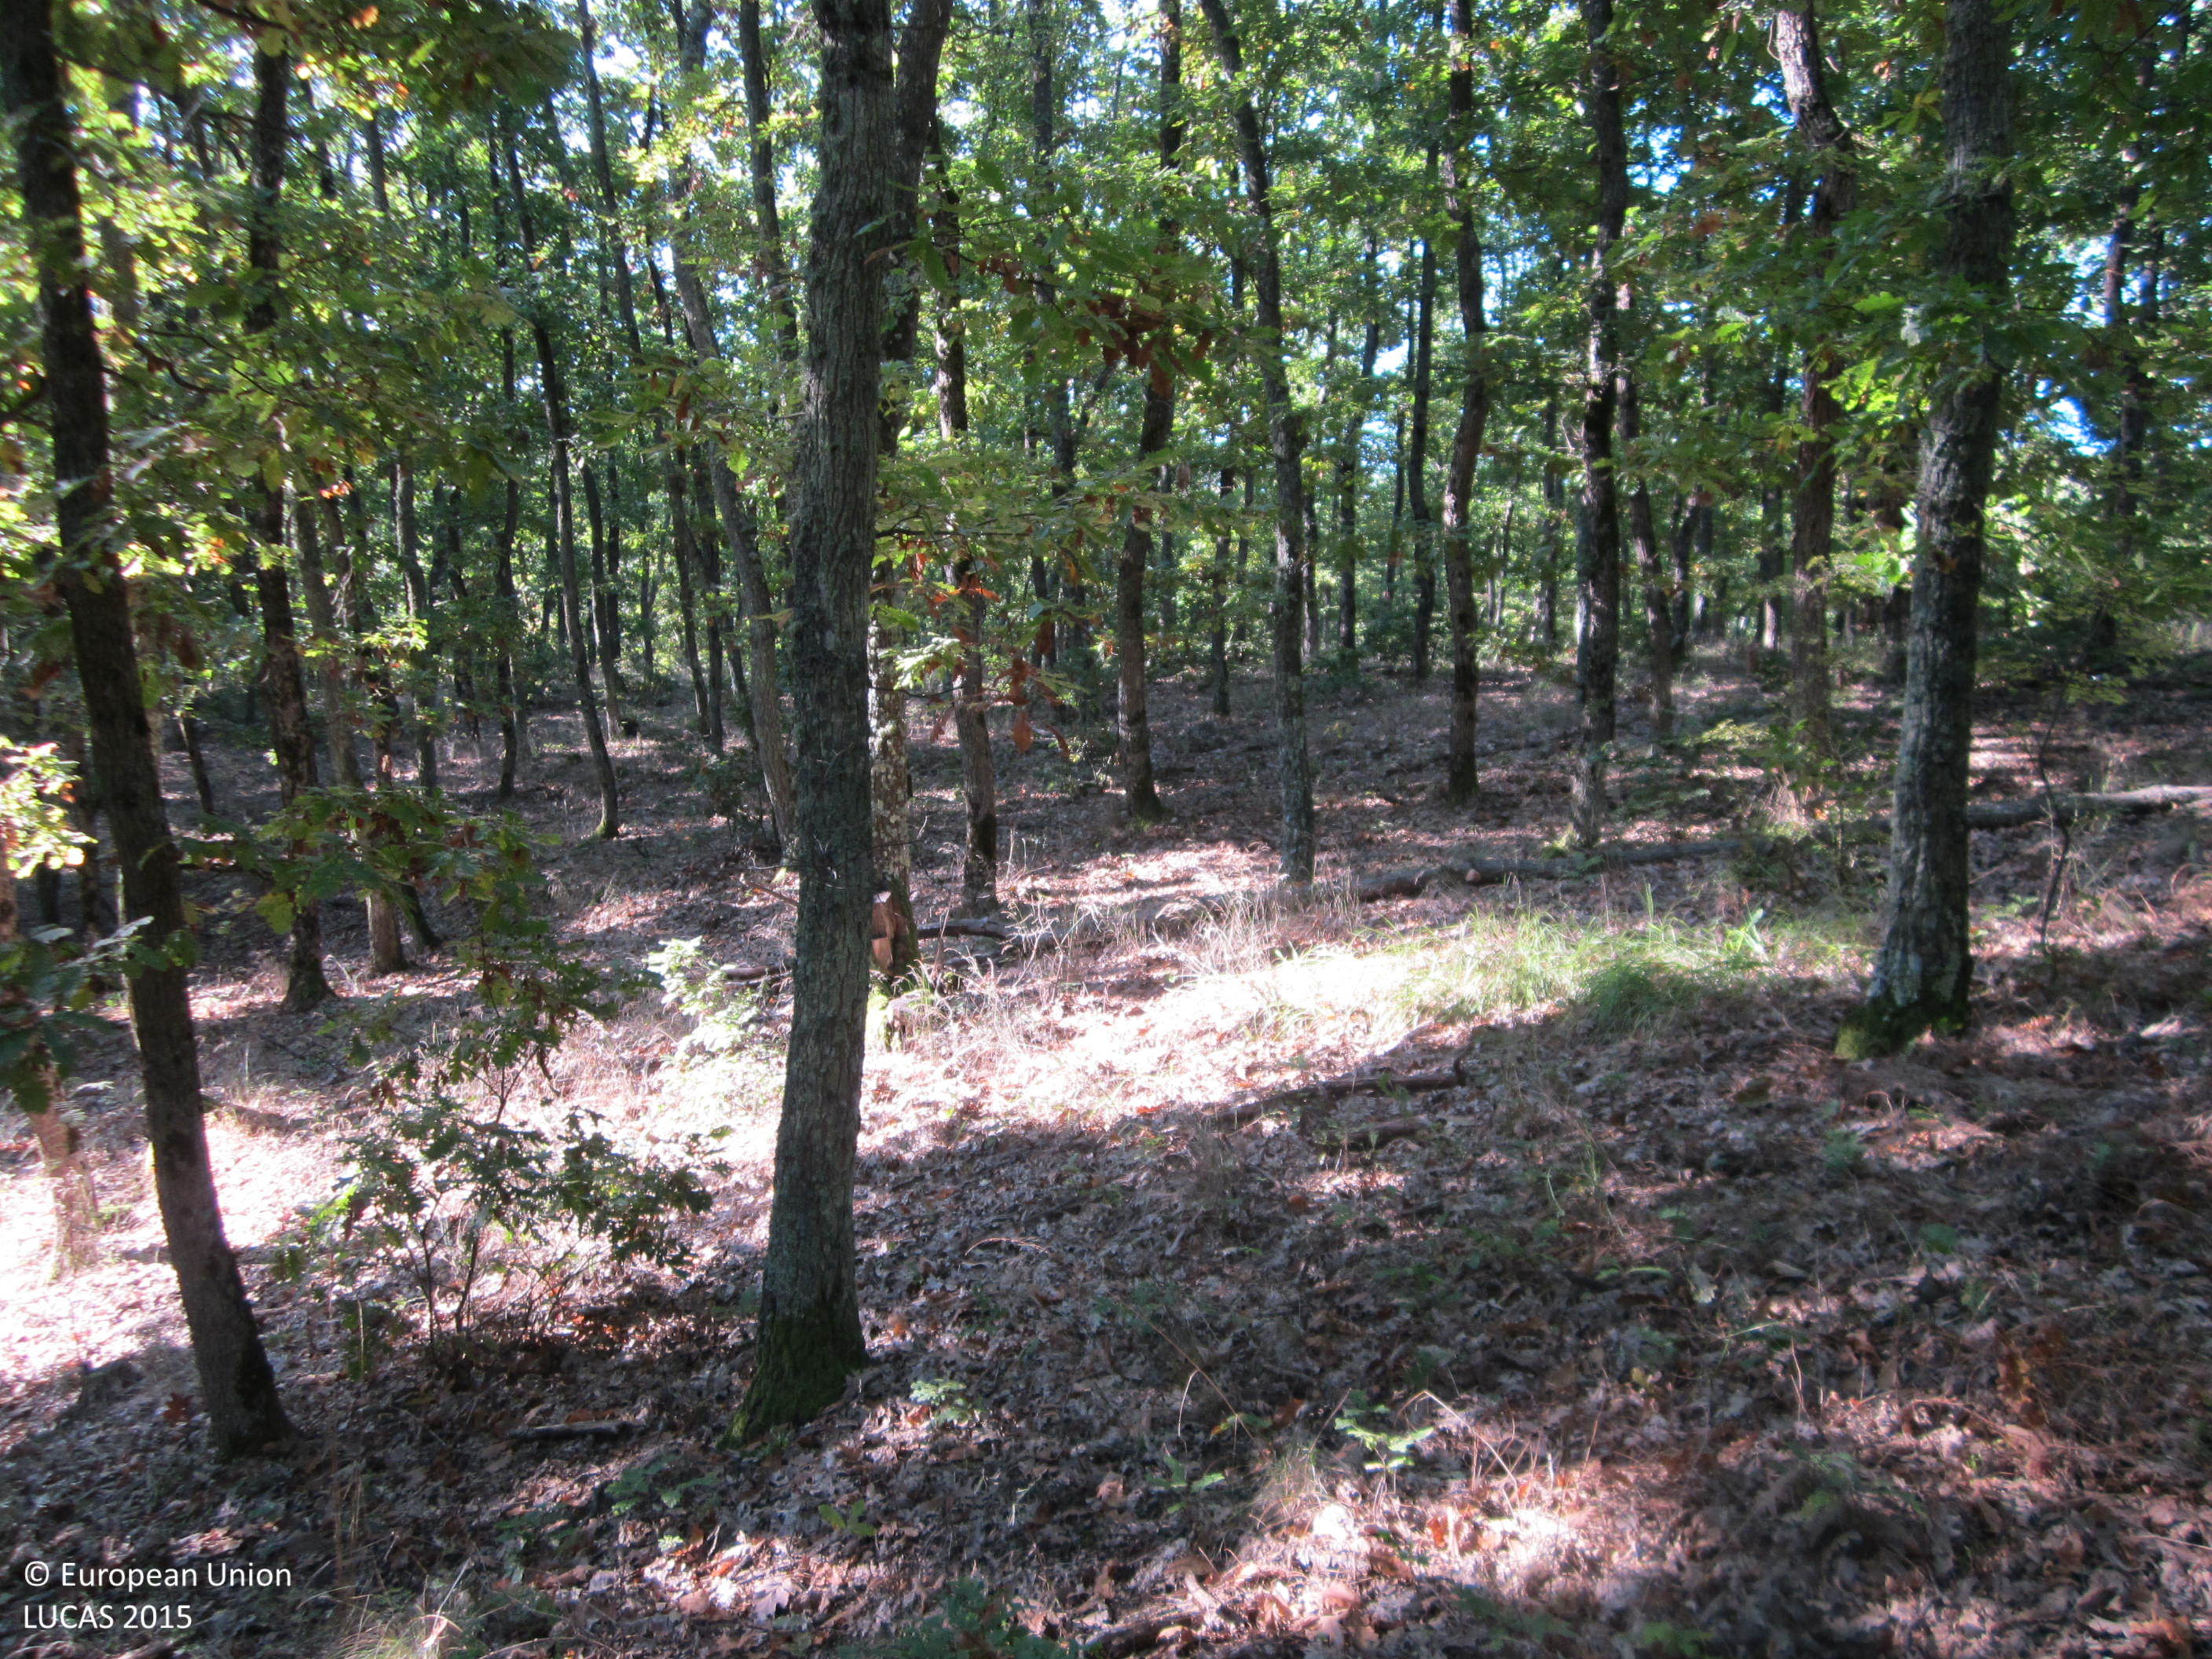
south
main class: Woodland
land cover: Broadleaved woodland
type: acidophilous oak and oak-birch forest
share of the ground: 50 - 75 %
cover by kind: broadleaved forest trees 70 %, unconsolidated bare surface 25 %, herbaceous plants 5 %
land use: Forestry
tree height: > 5 m
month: October
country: BG
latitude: 42.7891
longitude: 26.6649
